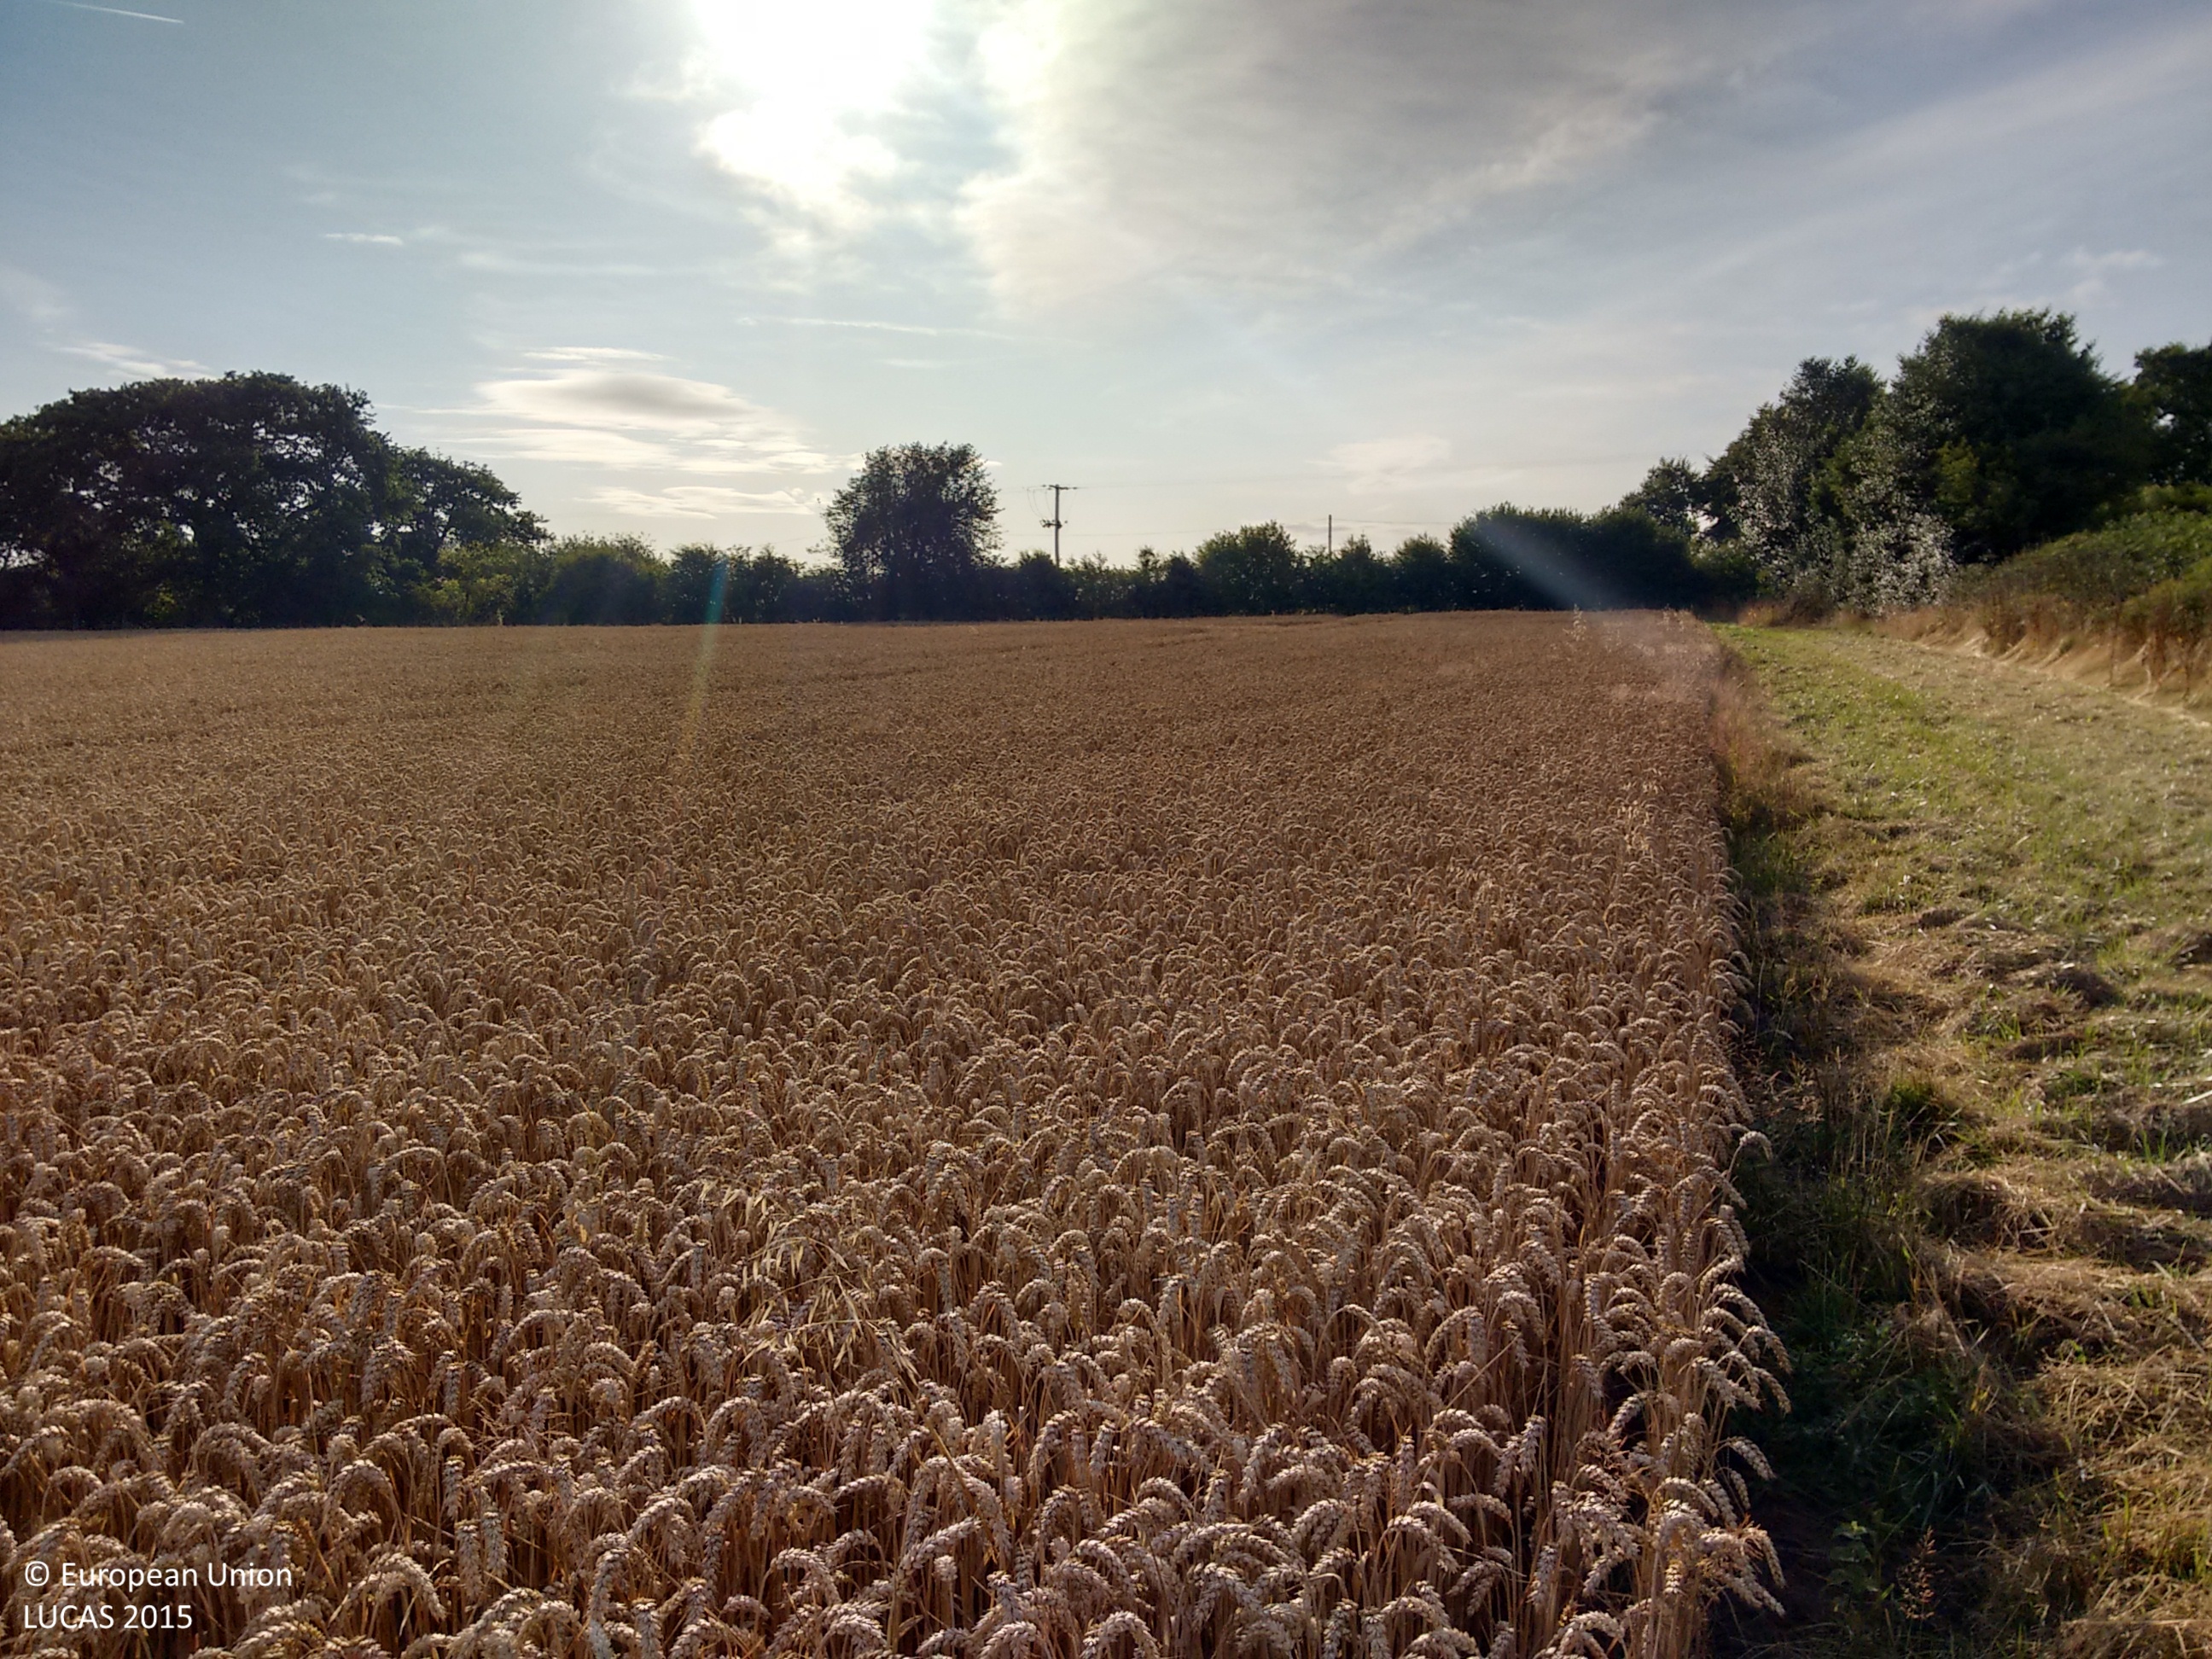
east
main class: Cropland
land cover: Common wheat
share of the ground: > 75 %
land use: Agriculture (excluding fallow land and kitchen gardens)
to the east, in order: Common wheat; Grass margins; Managed hedges; Broadleaved woodland; Grassland without tree/shrub cover; Electric lines; Grassland without tree/shrub cover; Electric lines; Tracks; Grassland without tree/shrub cover
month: August
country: GB
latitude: 52.8274
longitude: -2.6391
